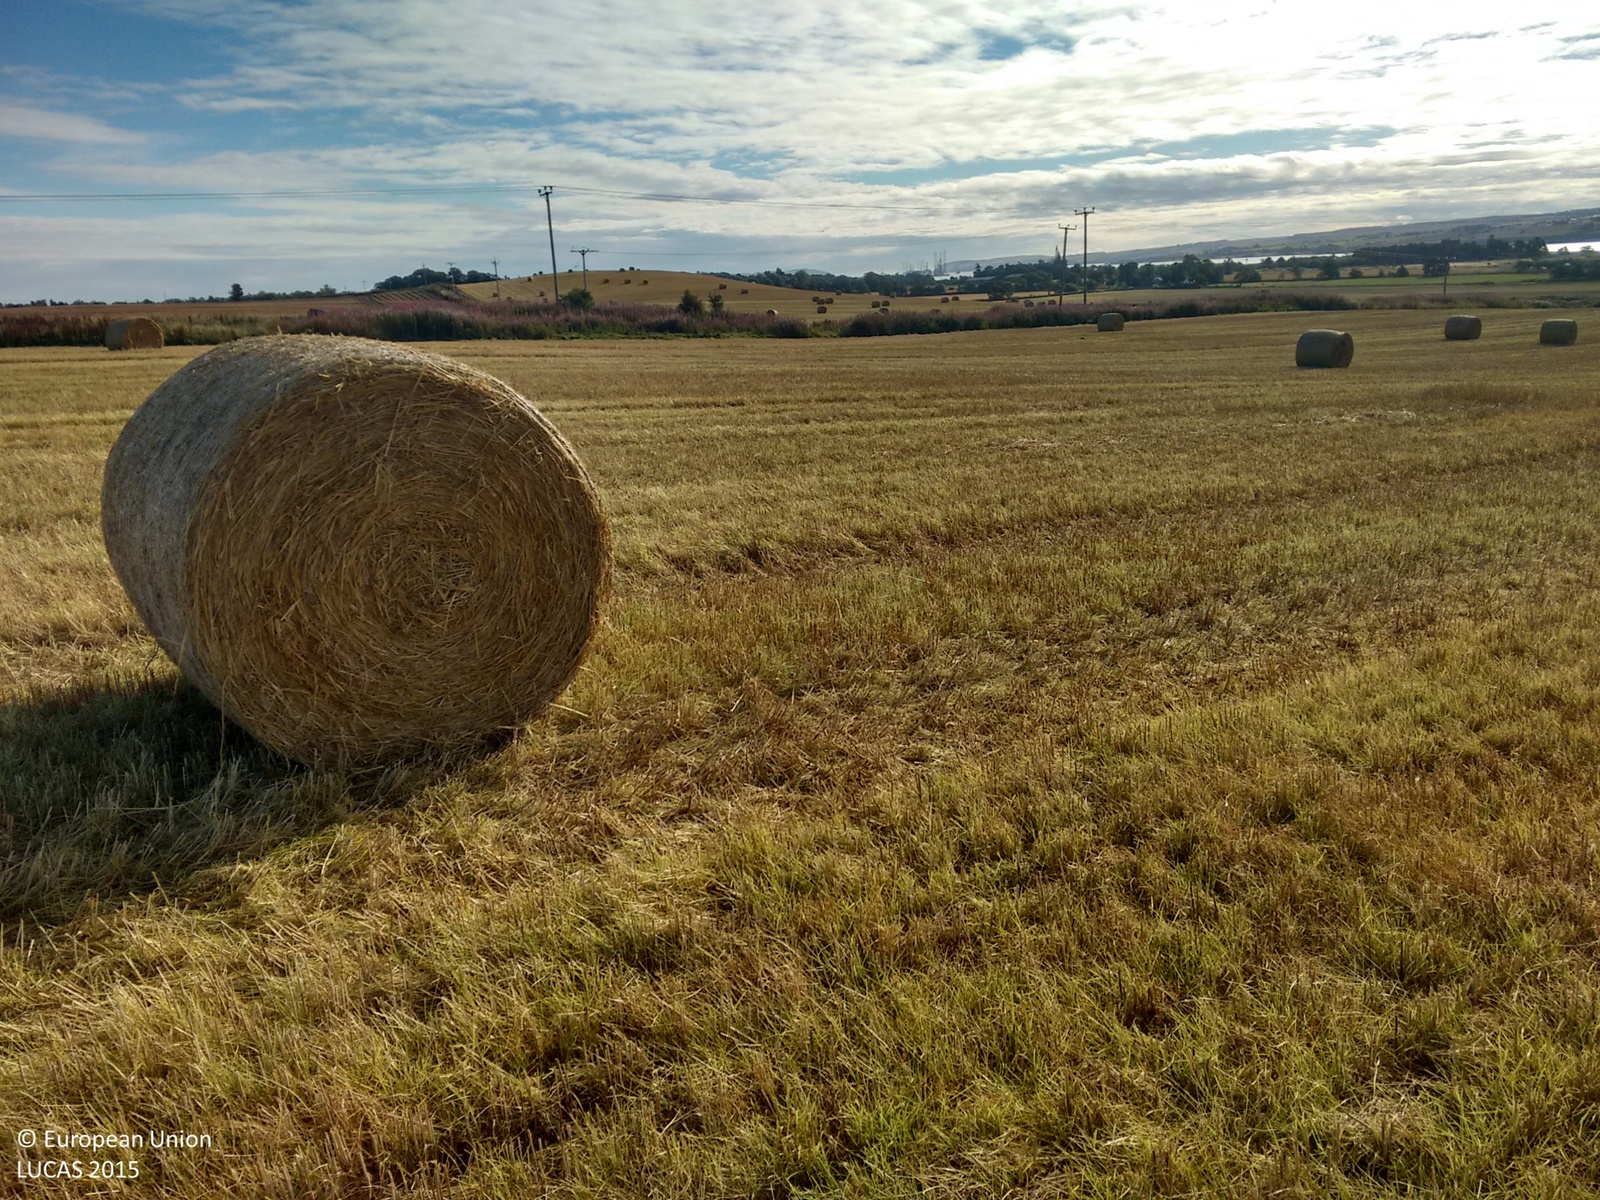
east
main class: Cropland
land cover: Common wheat
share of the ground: > 75 %
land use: Agriculture (excluding fallow land and kitchen gardens)
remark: Harvested field
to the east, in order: Common wheat; Grassland without tree/shrub cover; Electric lines; Grassland without tree/shrub cover; Common wheat; Electric lines; Common wheat
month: September
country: GB
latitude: 57.6880
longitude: -4.2927
